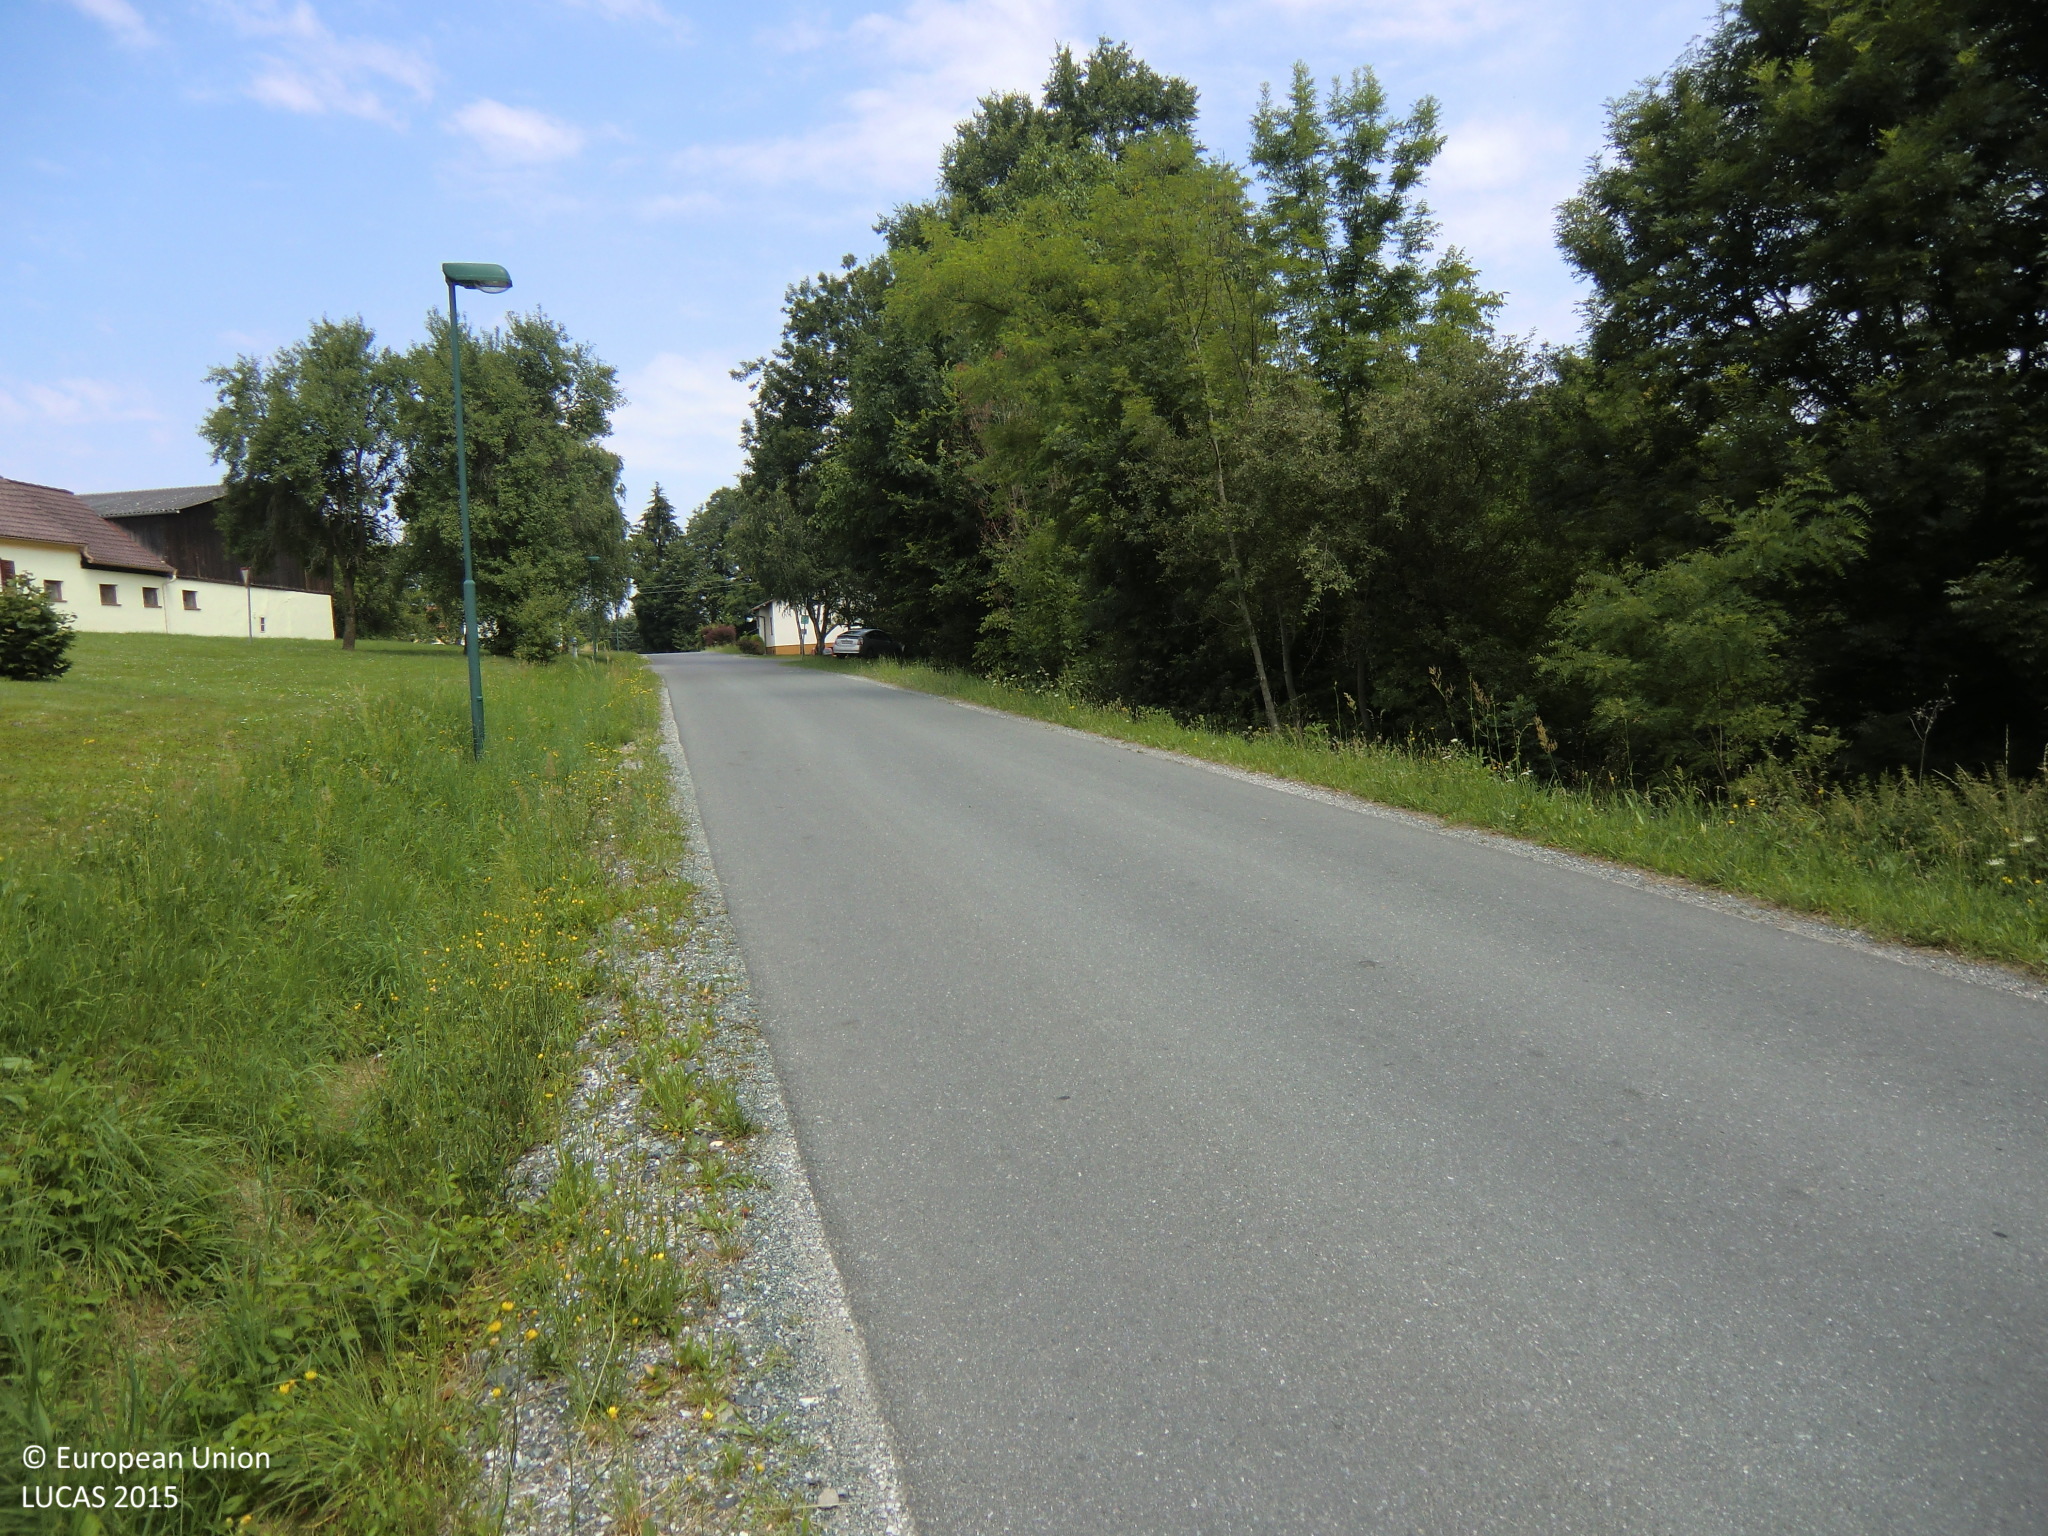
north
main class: Grassland
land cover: Grassland with sparse tree/shrub cover
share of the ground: > 75 %
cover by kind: herbaceous plants 95 %, broadleaved forest trees 5 %
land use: Residential
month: July
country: AT
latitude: 47.0785
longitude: 16.1258
